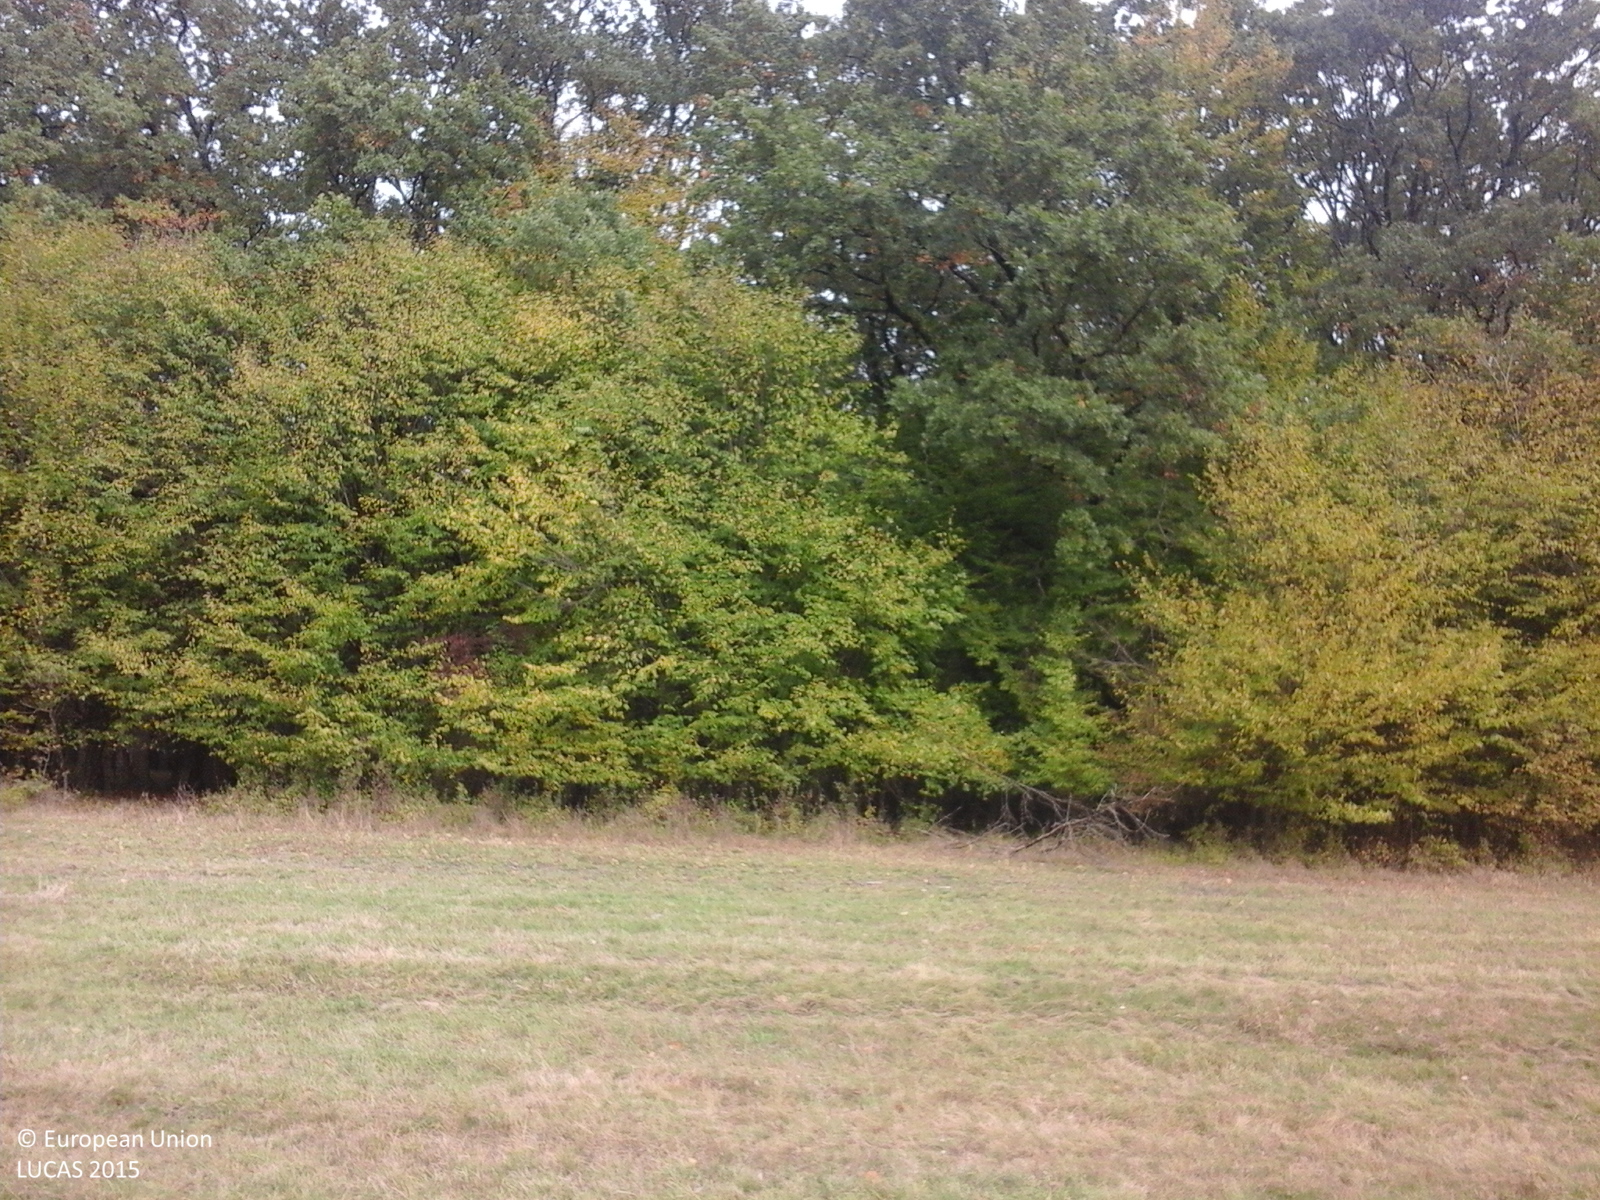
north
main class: Grassland
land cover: Grassland without tree/shrub cover
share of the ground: > 75 %
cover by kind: herbaceous plants 100 %
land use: Agriculture (excluding fallow land and kitchen gardens)
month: October
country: RO
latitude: 45.8657
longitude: 24.6541
